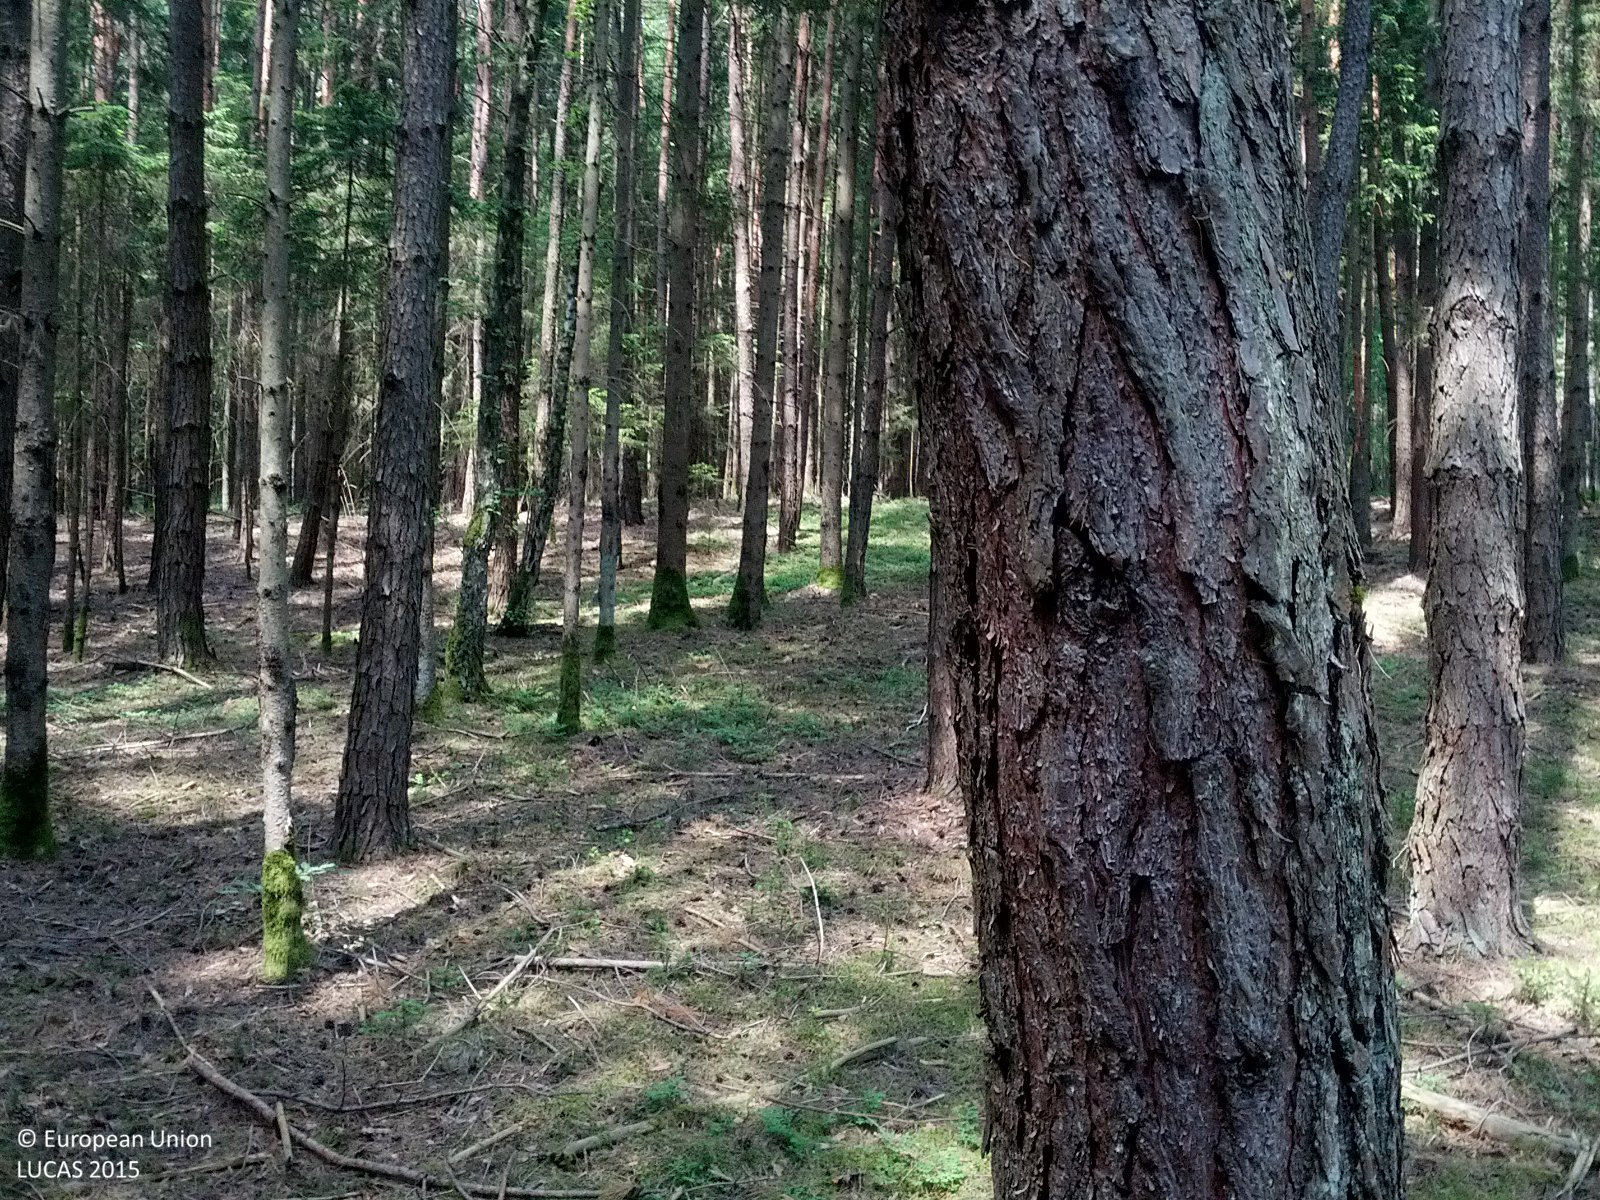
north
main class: Woodland
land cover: Pine dominated coniferous woodland
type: boreal forest
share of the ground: > 75 %
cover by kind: coniferous forest trees 80 %, lichens and mosses 10 %, shrubs 5 %, herbaceous plants 5 %
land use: Forestry
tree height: > 5 m
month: May
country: AT
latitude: 47.3311
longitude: 16.1290
